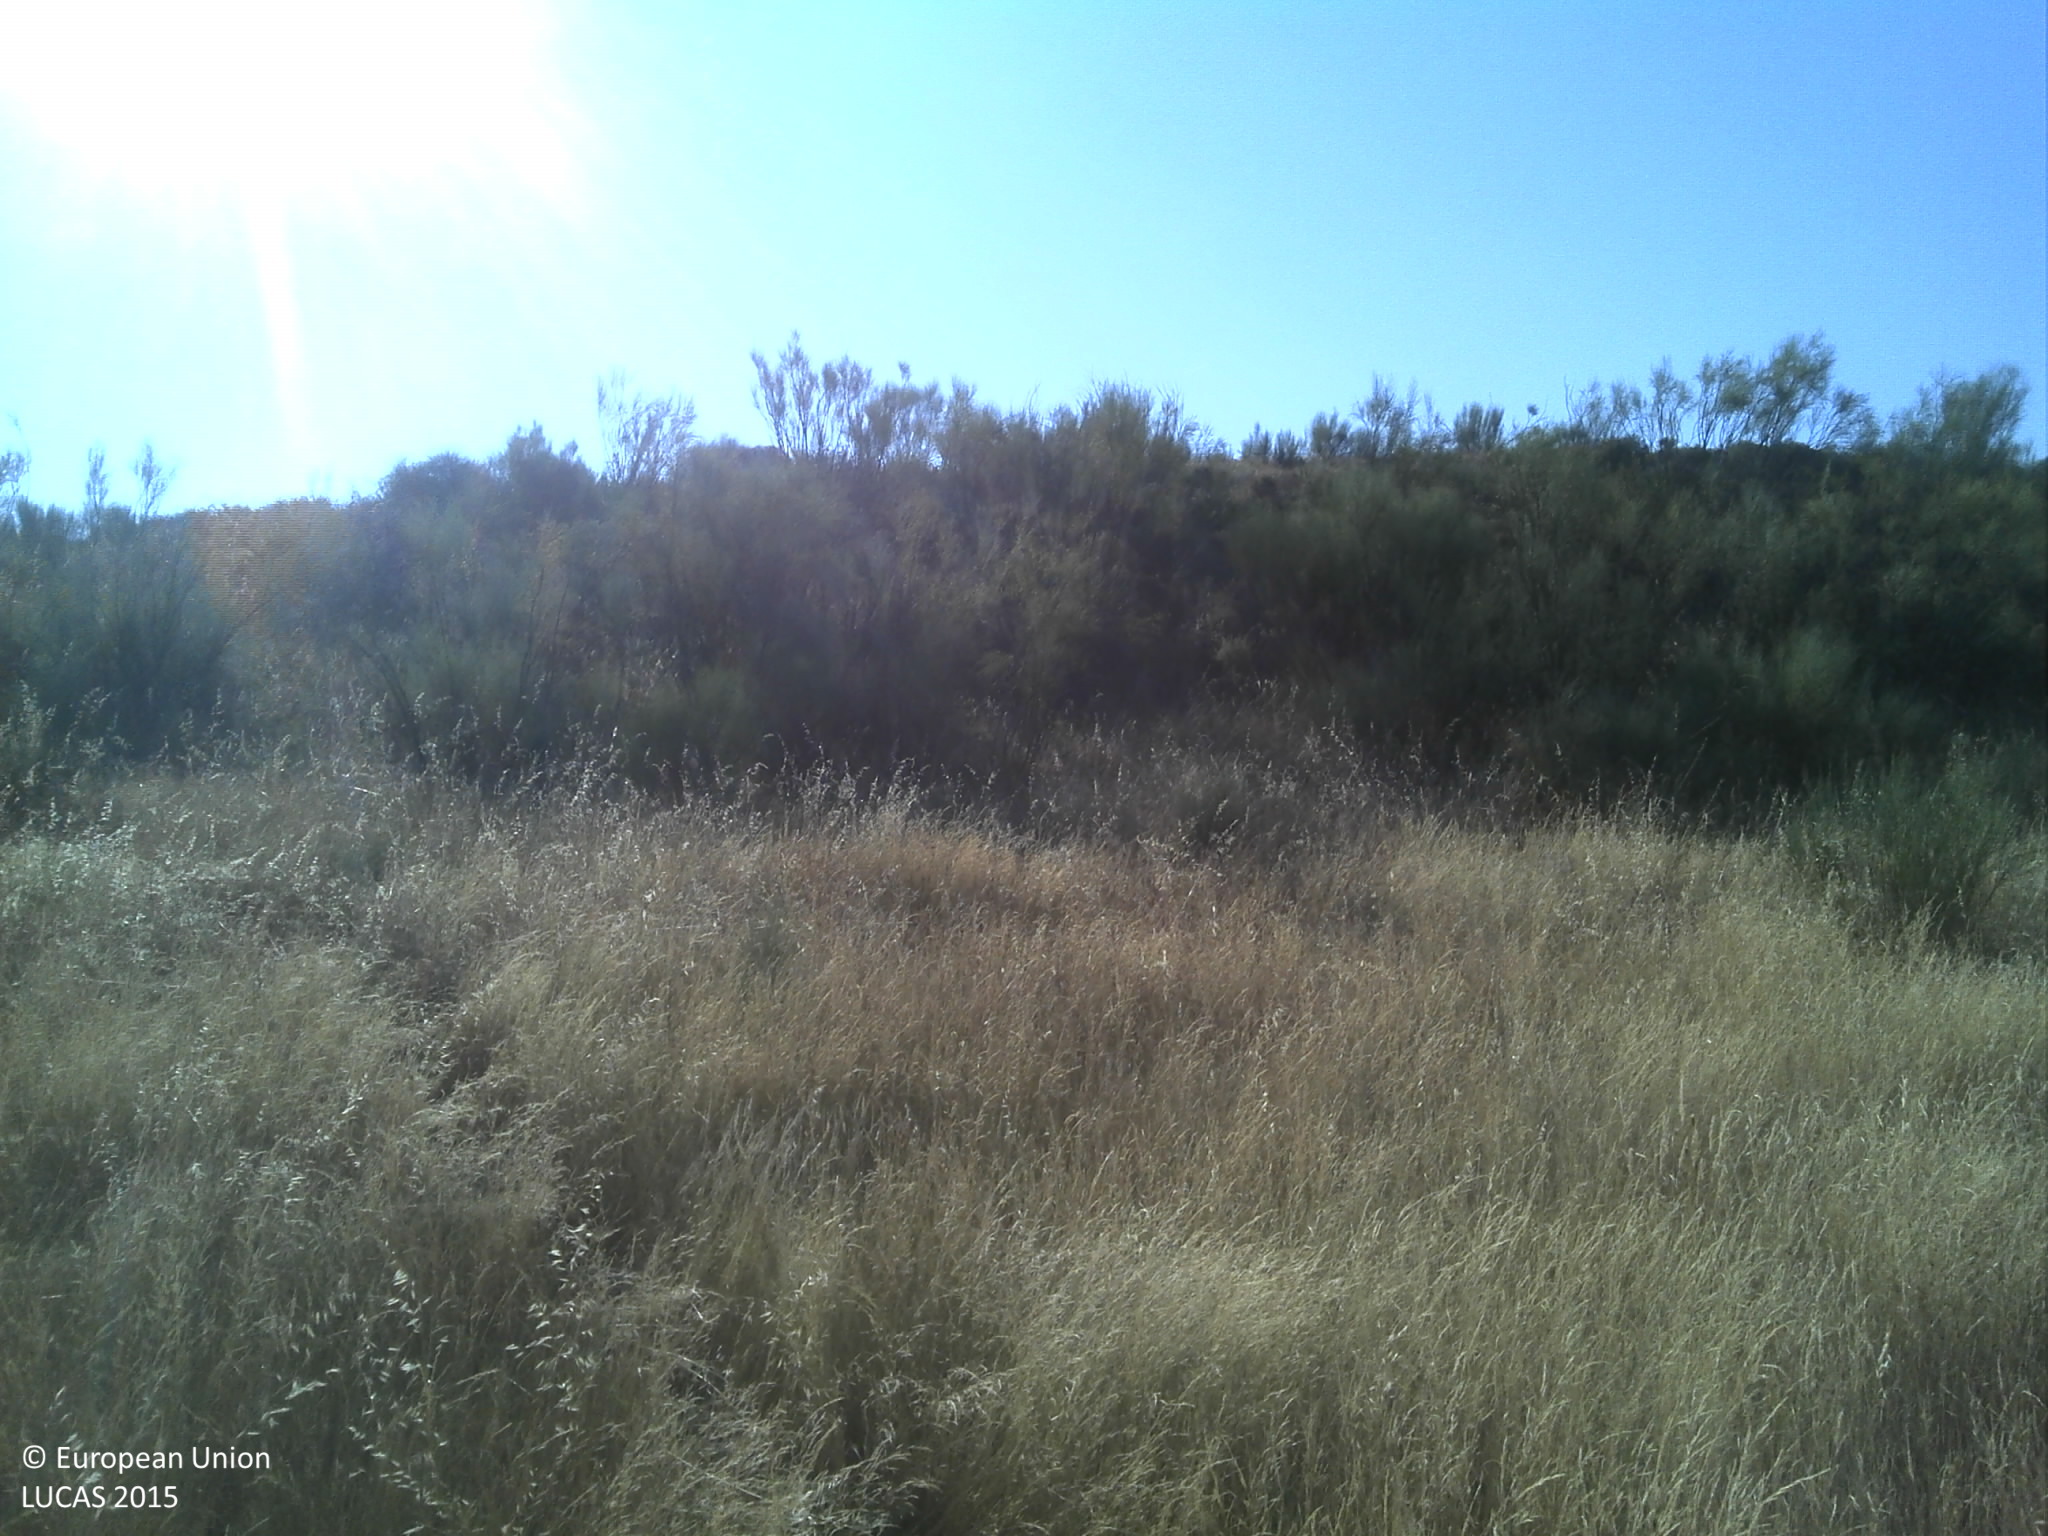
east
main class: Grassland
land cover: Grassland without tree/shrub cover
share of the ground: 50 - 75 %
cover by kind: herbaceous plants 65 %, unconsolidated bare surface 25 %, shrubs 5 %
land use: Agriculture (excluding fallow land and kitchen gardens)
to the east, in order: Grassland without tree/shrub cover; Shrubland without tree cover; Tracks; Shrubland without tree cover; Grassland without tree/shrub cover; Shrubland without tree cover
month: June
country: PT
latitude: 39.7155
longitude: -7.0834
